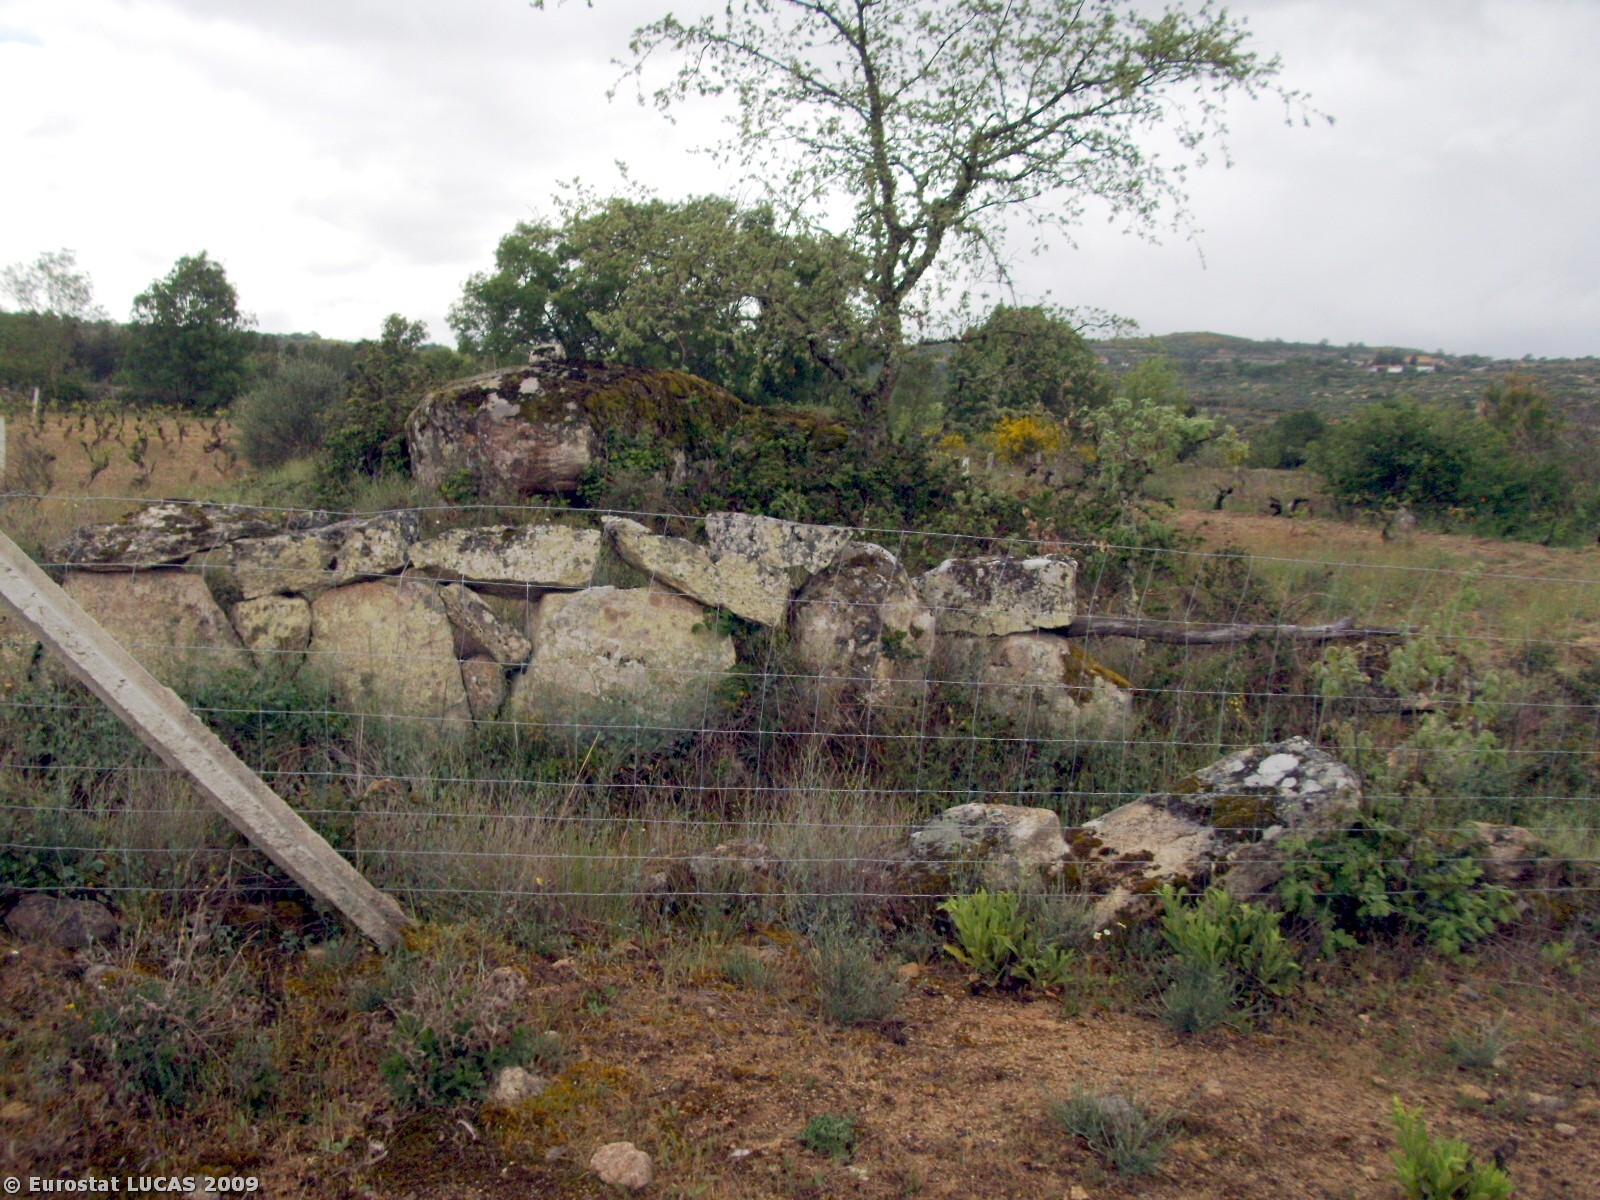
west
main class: Grassland
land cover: Spontaneously vegetated surfaces
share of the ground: > 75 %
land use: Fallow land
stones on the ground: 25 - 50 %
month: May
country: PT
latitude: 40.6881
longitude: -7.1083
